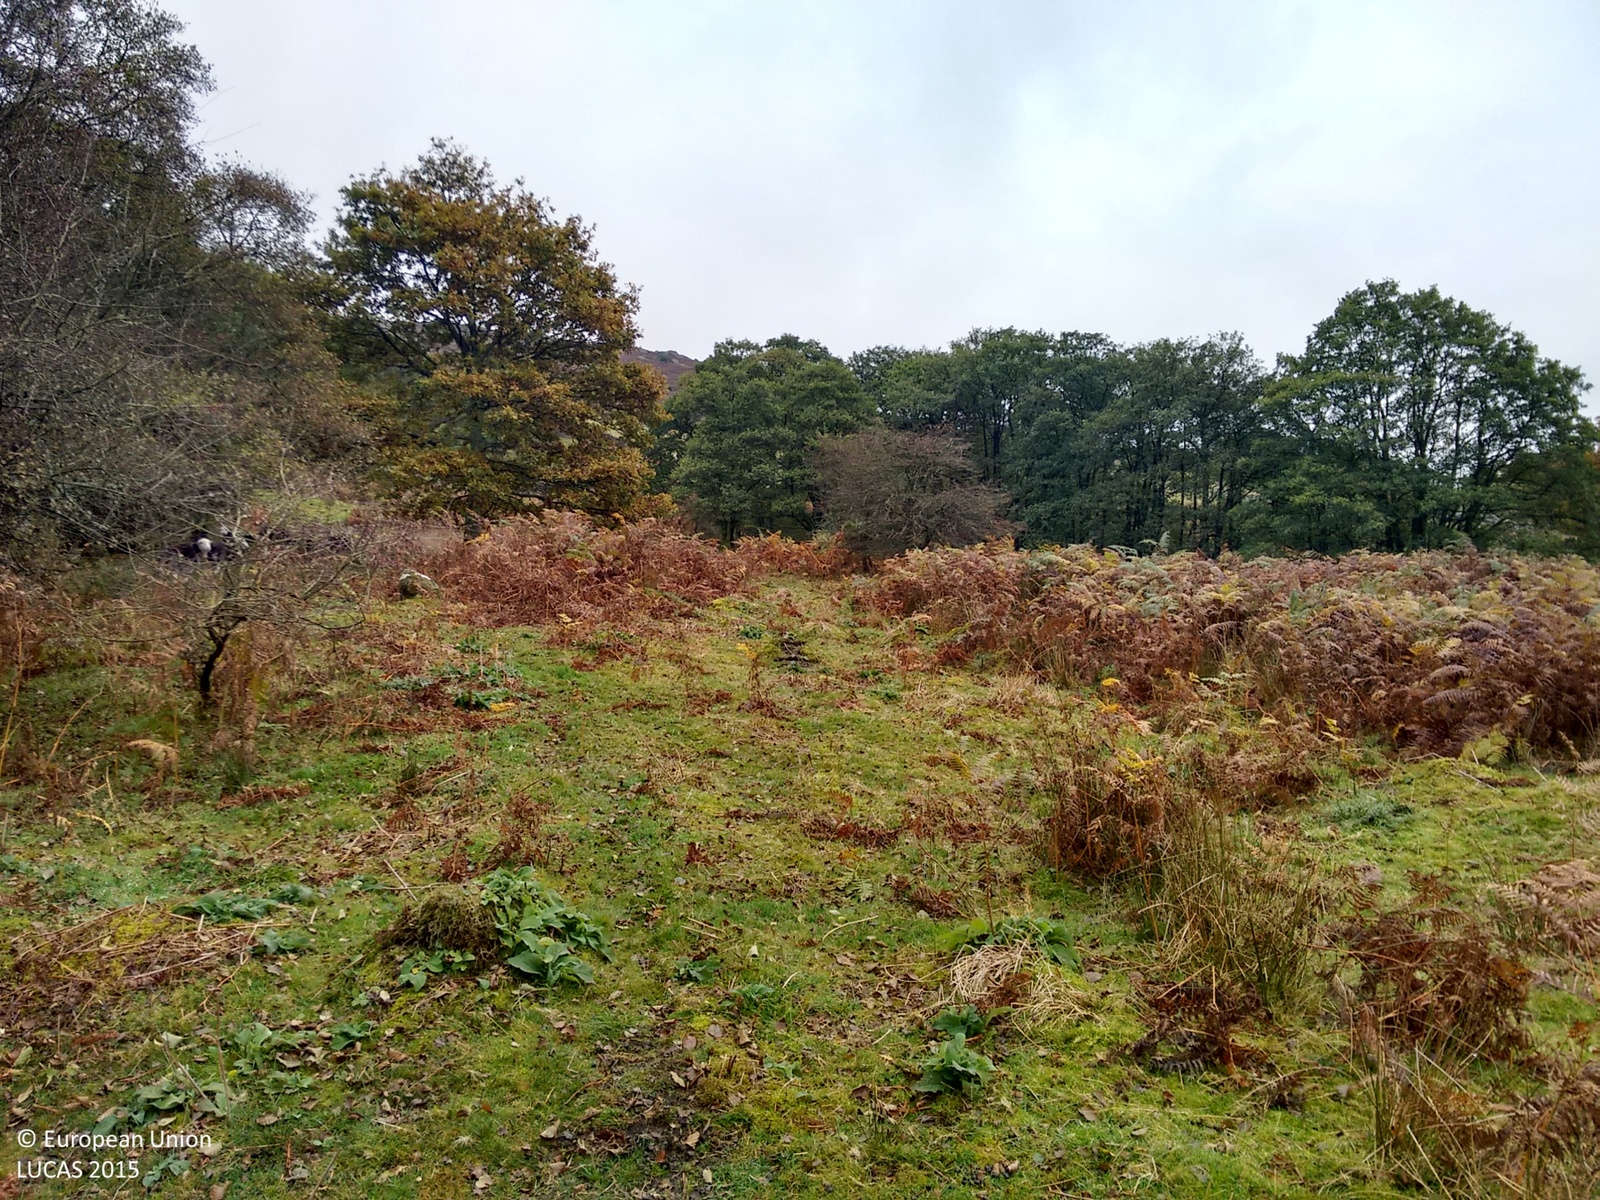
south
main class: Grassland
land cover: Grassland with sparse tree/shrub cover
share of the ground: > 75 %
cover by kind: herbaceous plants 90 %, broadleaved forest trees 5 %, shrubs 5 %
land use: Agriculture (excluding fallow land and kitchen gardens)
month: October
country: GB
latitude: 54.3317
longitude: -3.2254
